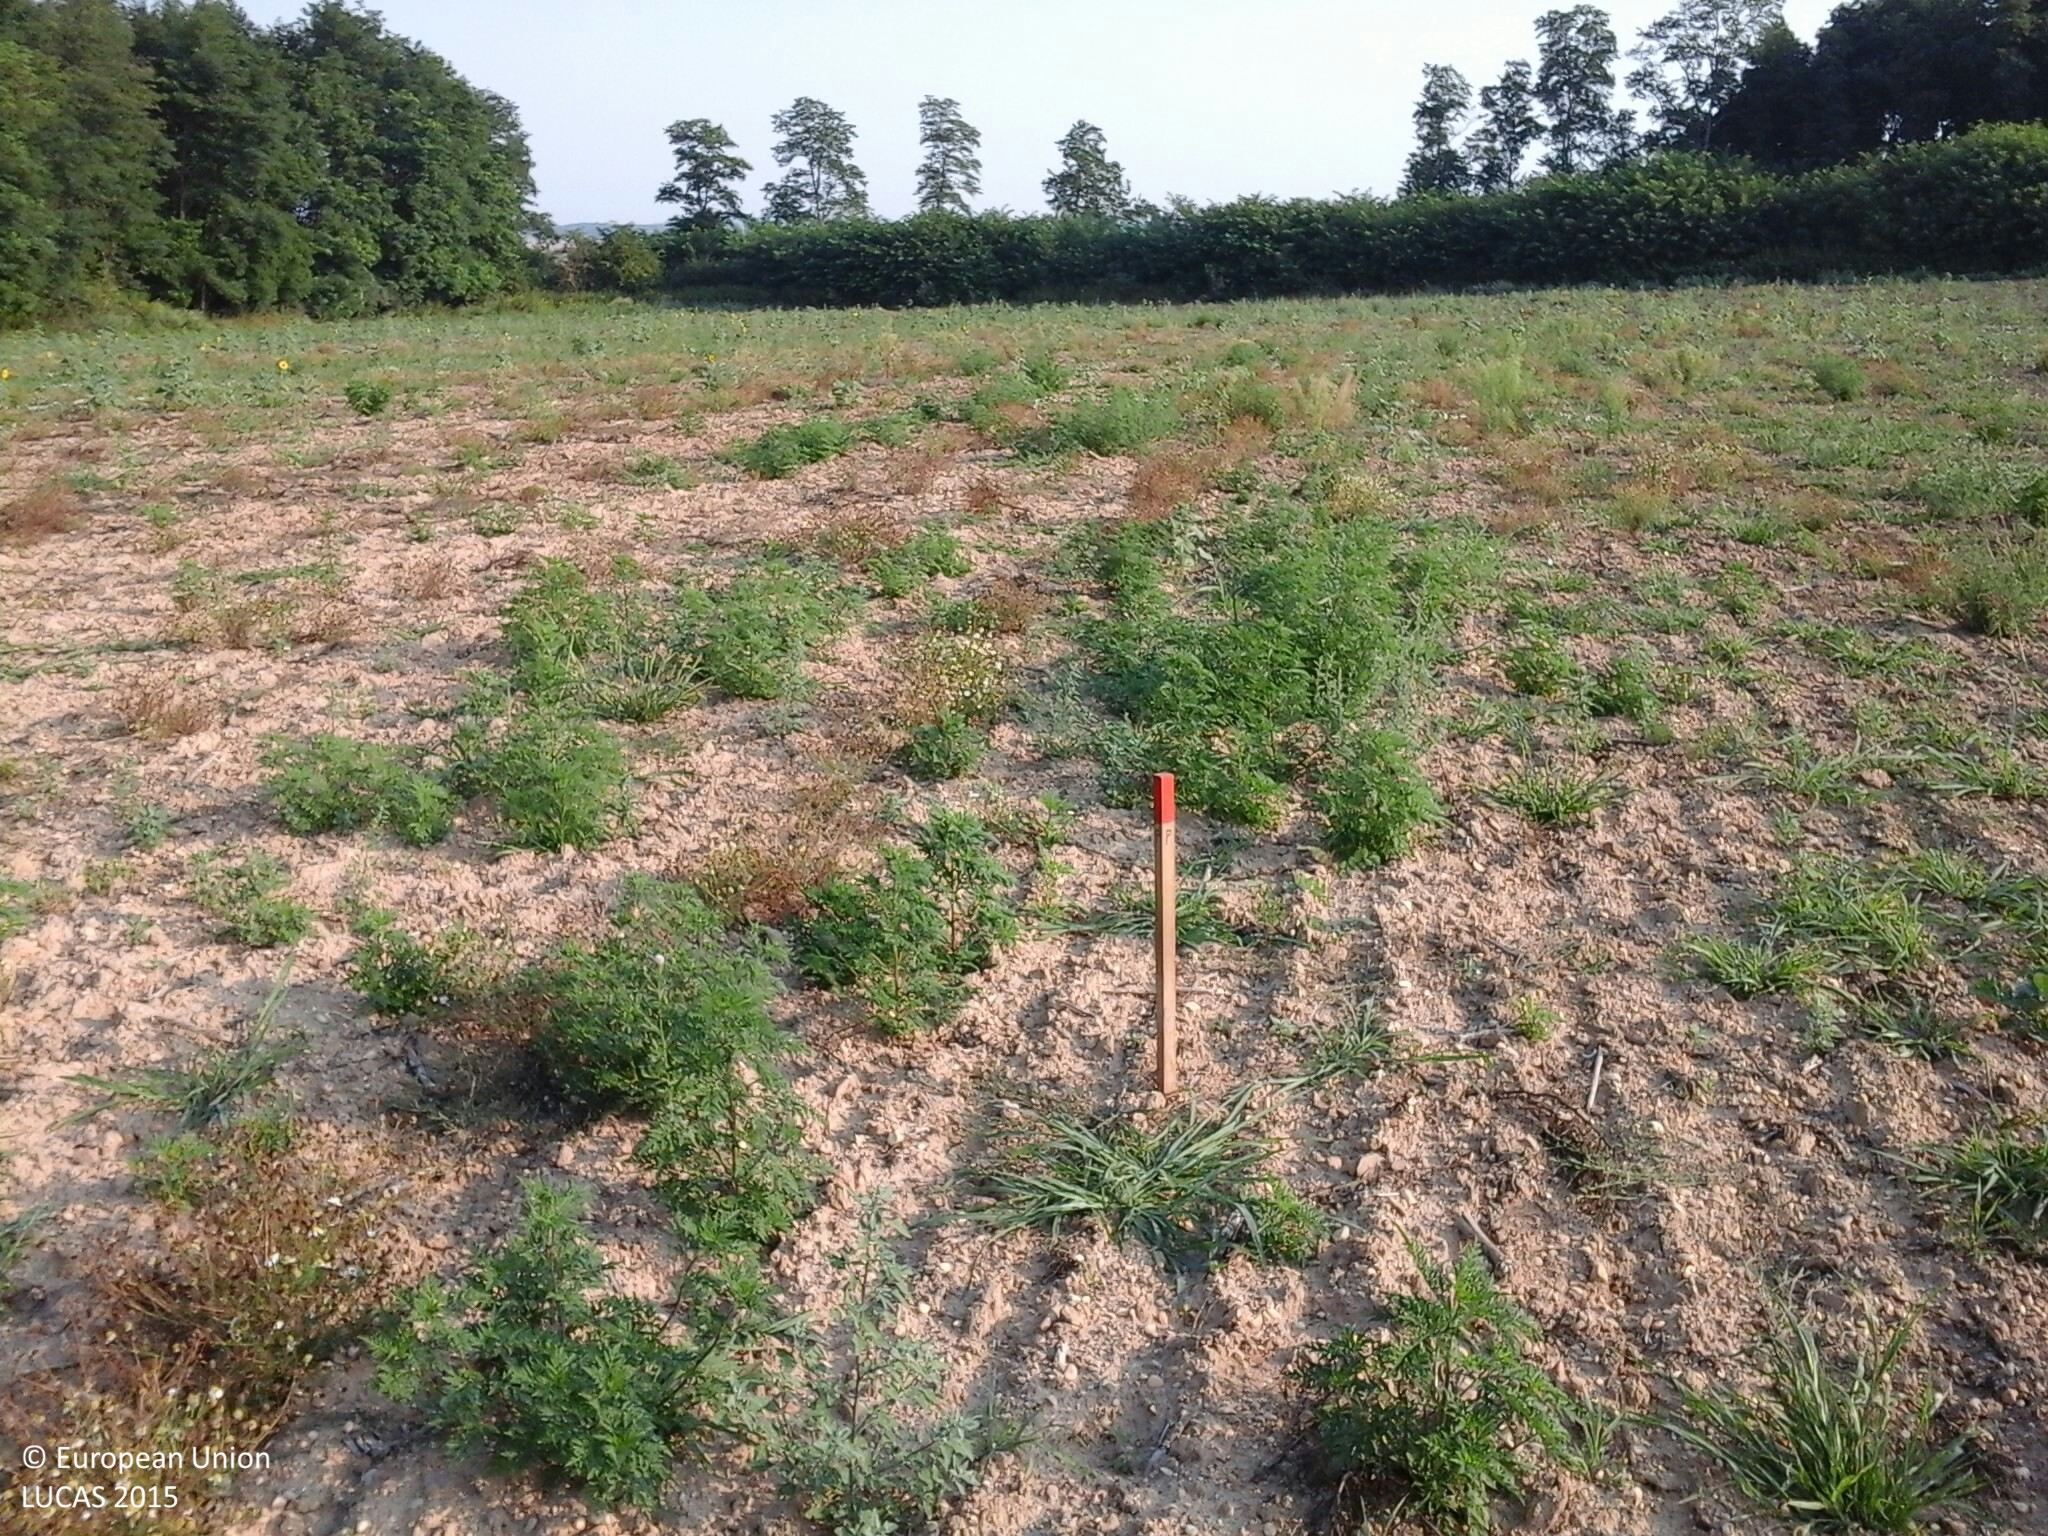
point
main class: Grassland
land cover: Spontaneously vegetated surfaces
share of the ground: < 10 %
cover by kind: herbaceous plants 55 %, unconsolidated bare surface 45 %
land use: Fallow land
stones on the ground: 25 - 50 %
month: August
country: HU
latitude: 47.0891
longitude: 17.1317
